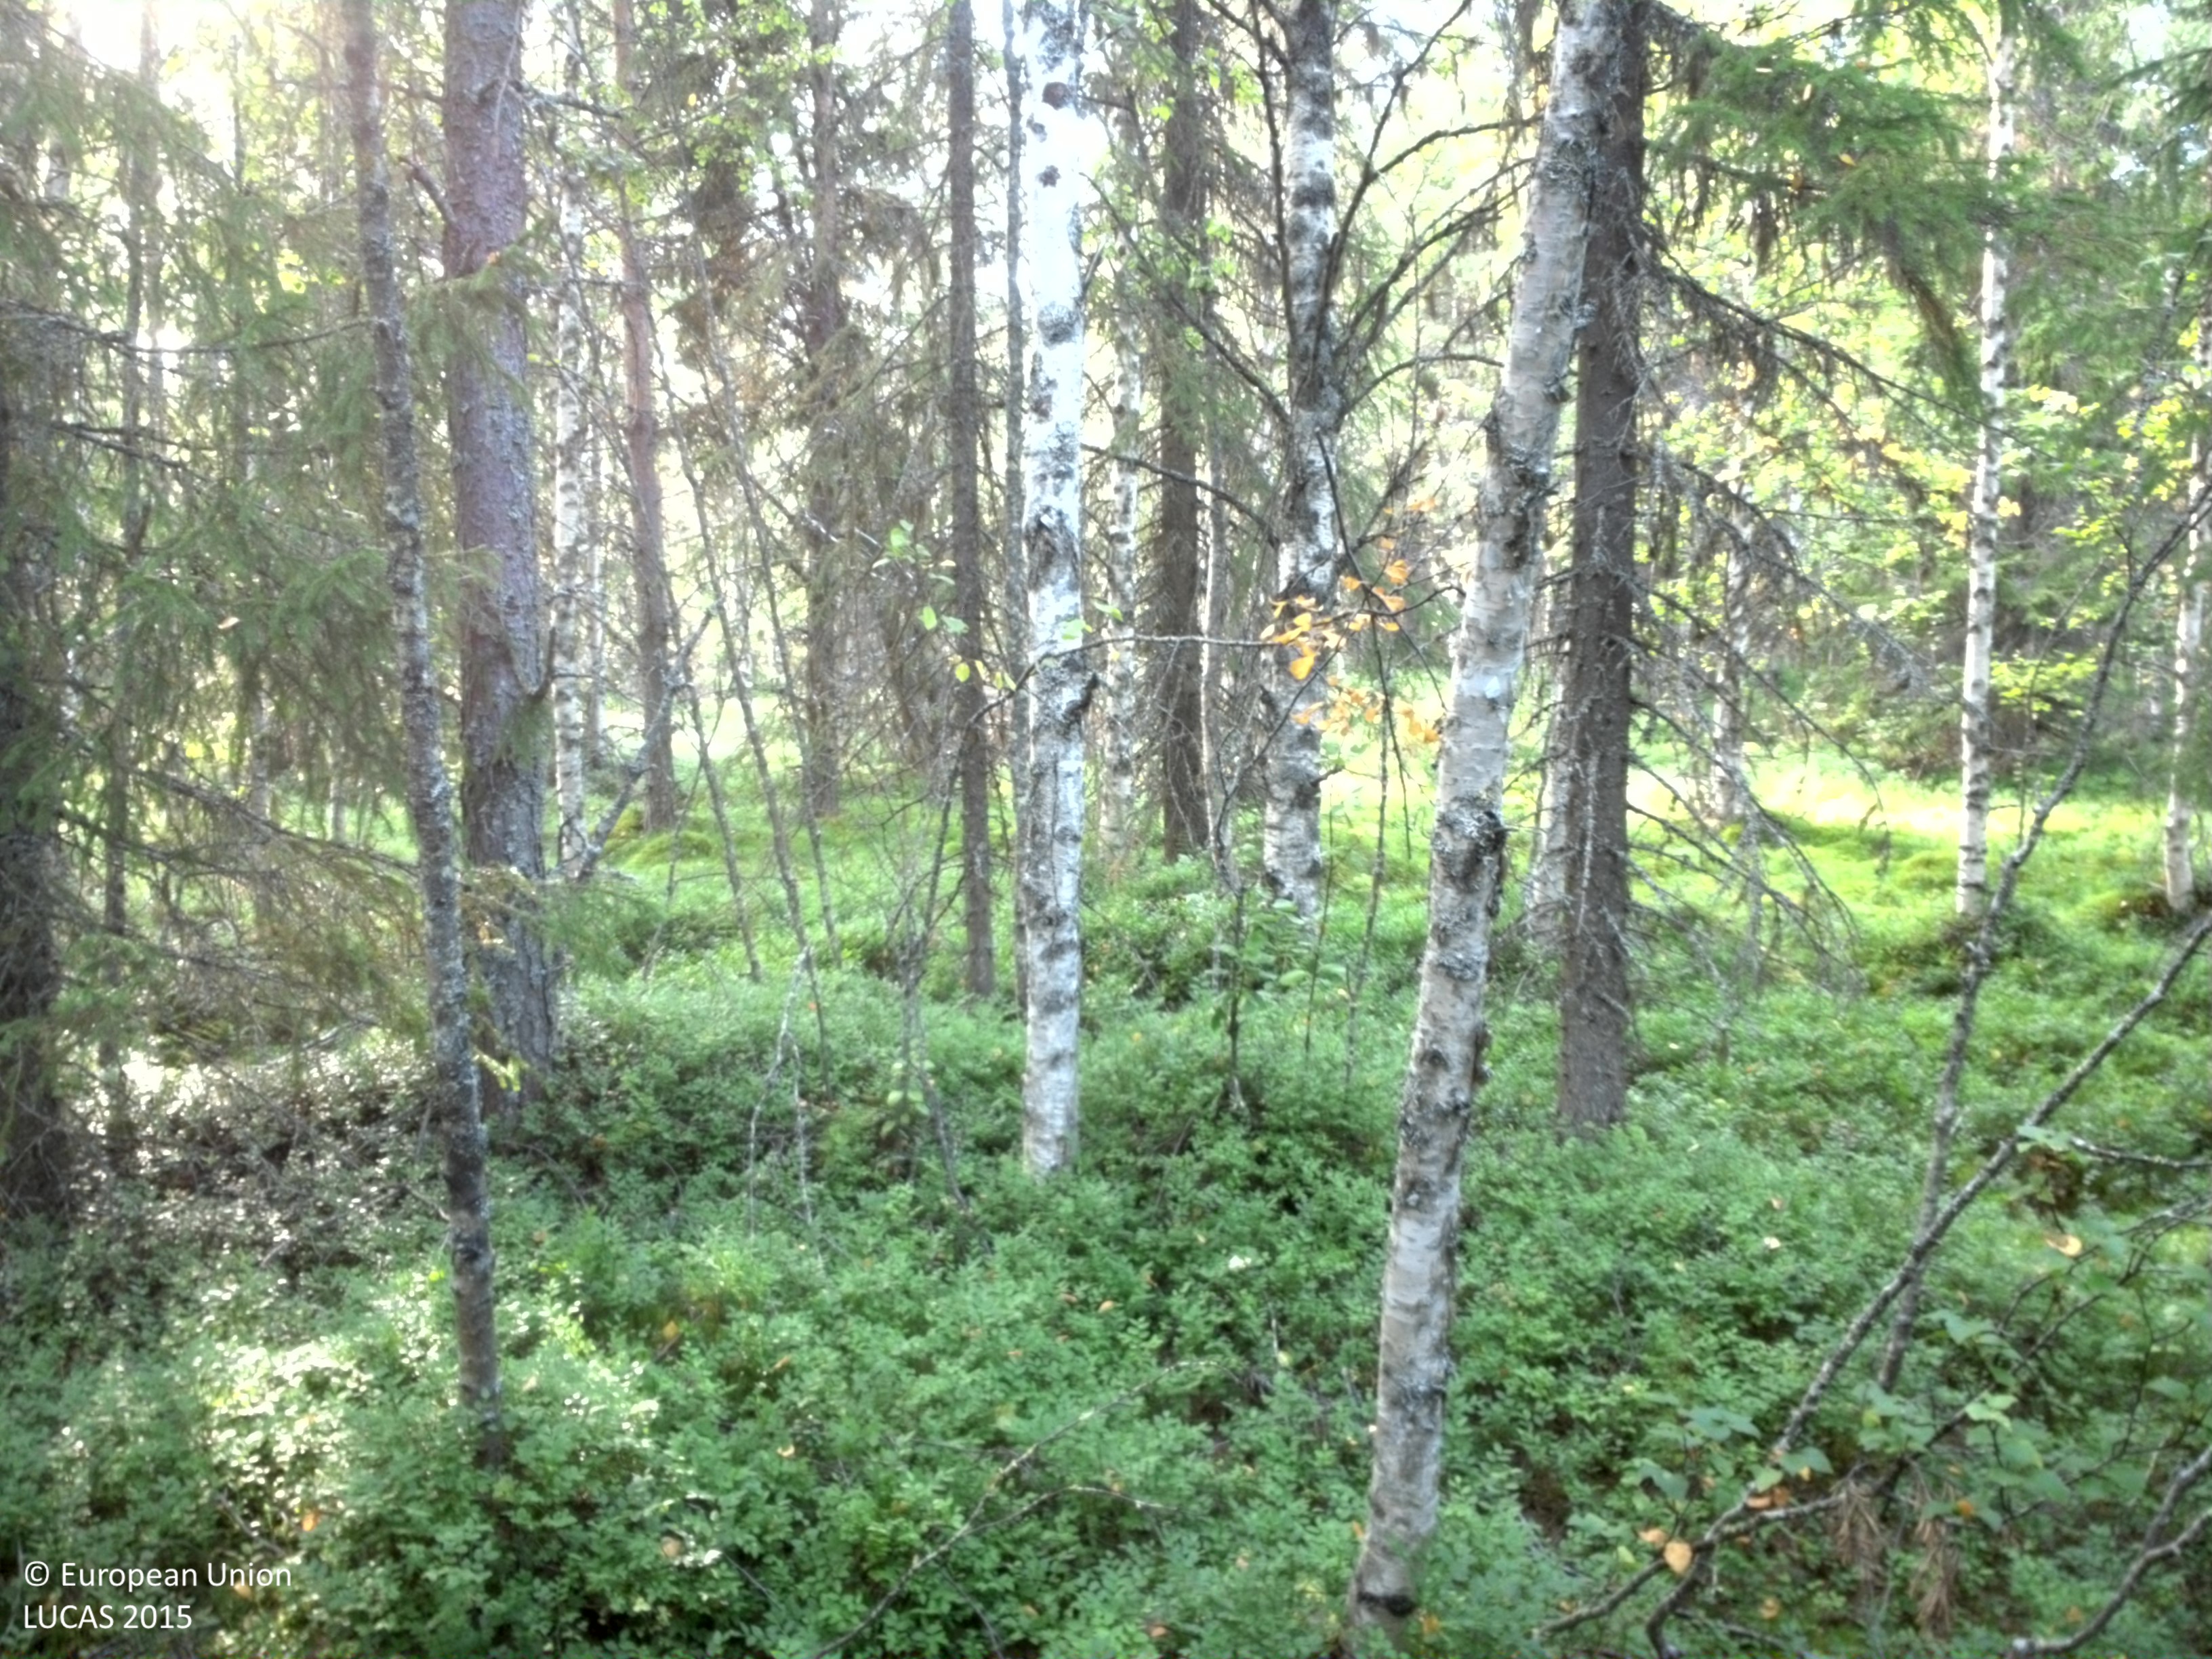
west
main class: Woodland
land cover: Spruce dominated mixed woodland
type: boreal forest
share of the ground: 50 - 75 %
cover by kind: coniferous forest trees 40 %, broadleaved forest trees 25 %, shrubs 25 %, lichens and mosses 10 %
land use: Forestry
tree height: > 5 m
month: August
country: SE
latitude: 64.7381
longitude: 16.4559
